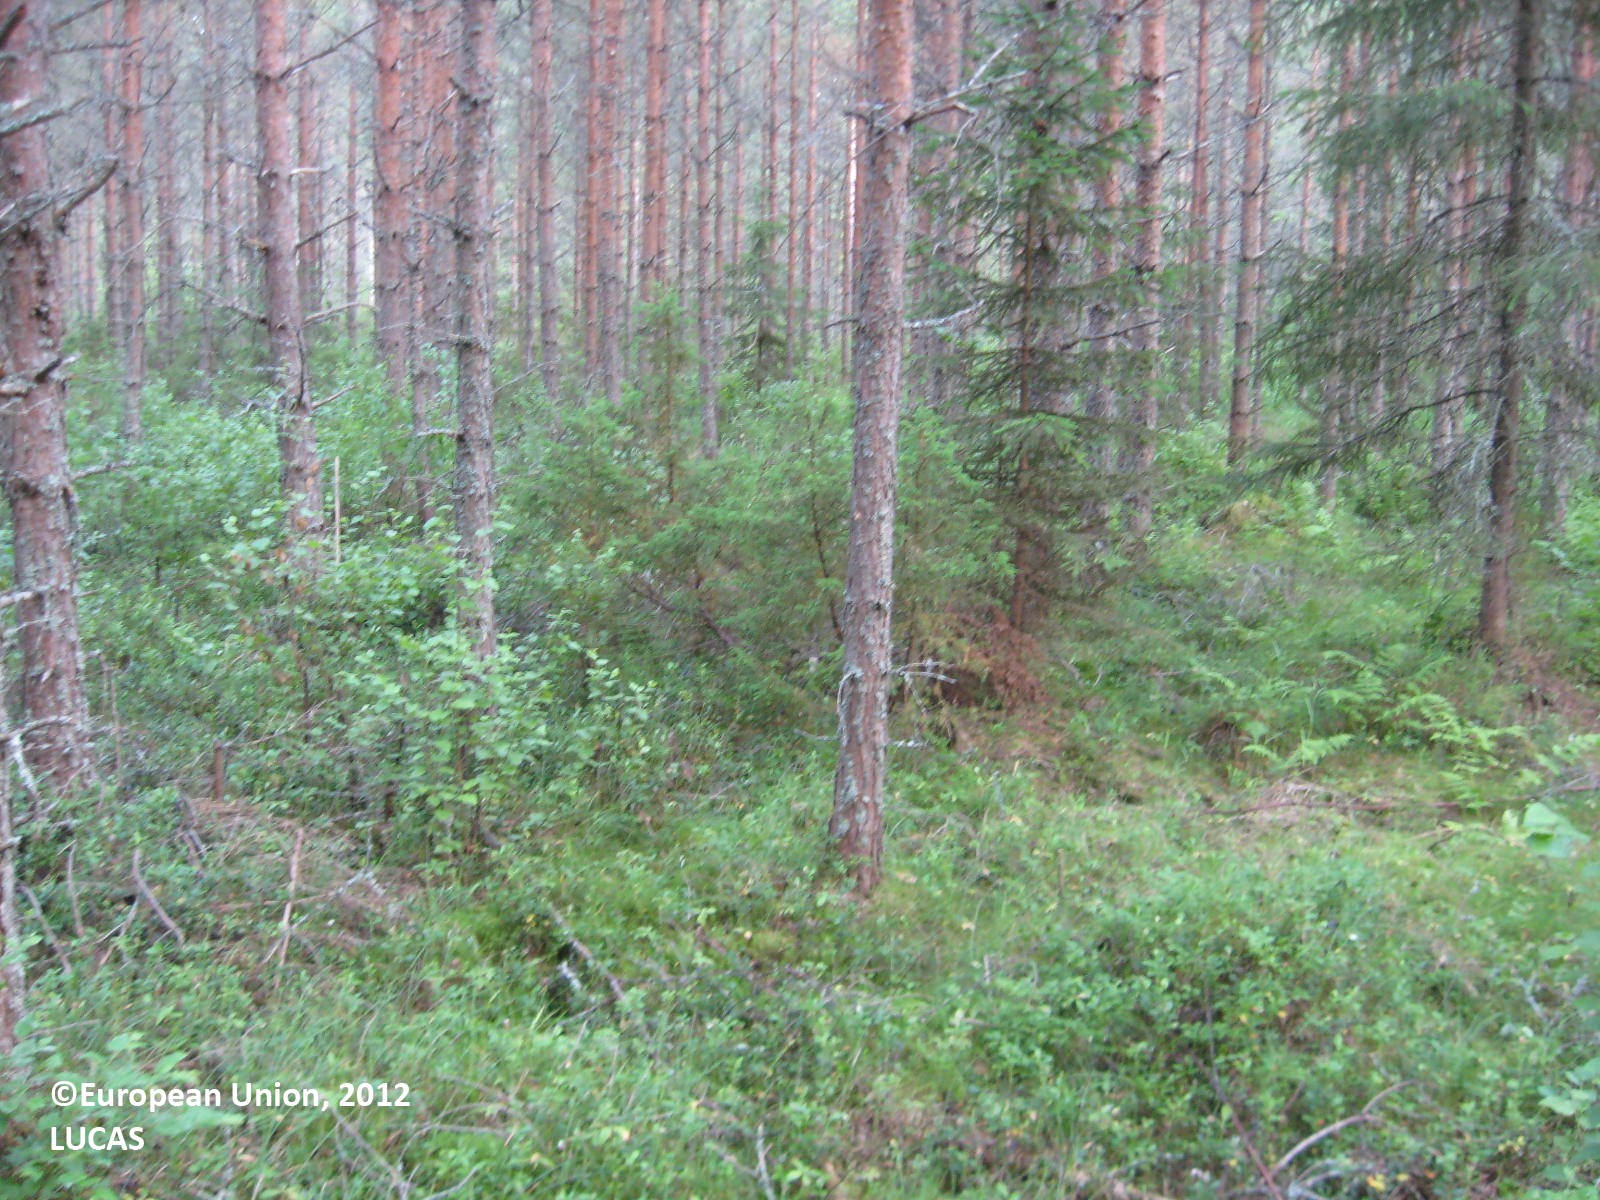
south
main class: Woodland
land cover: Pine dominated coniferous woodland
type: boreal forest
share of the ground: > 75 %
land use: Forestry
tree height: > 5 m
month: July
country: FI
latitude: 62.5893
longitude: 21.5111
